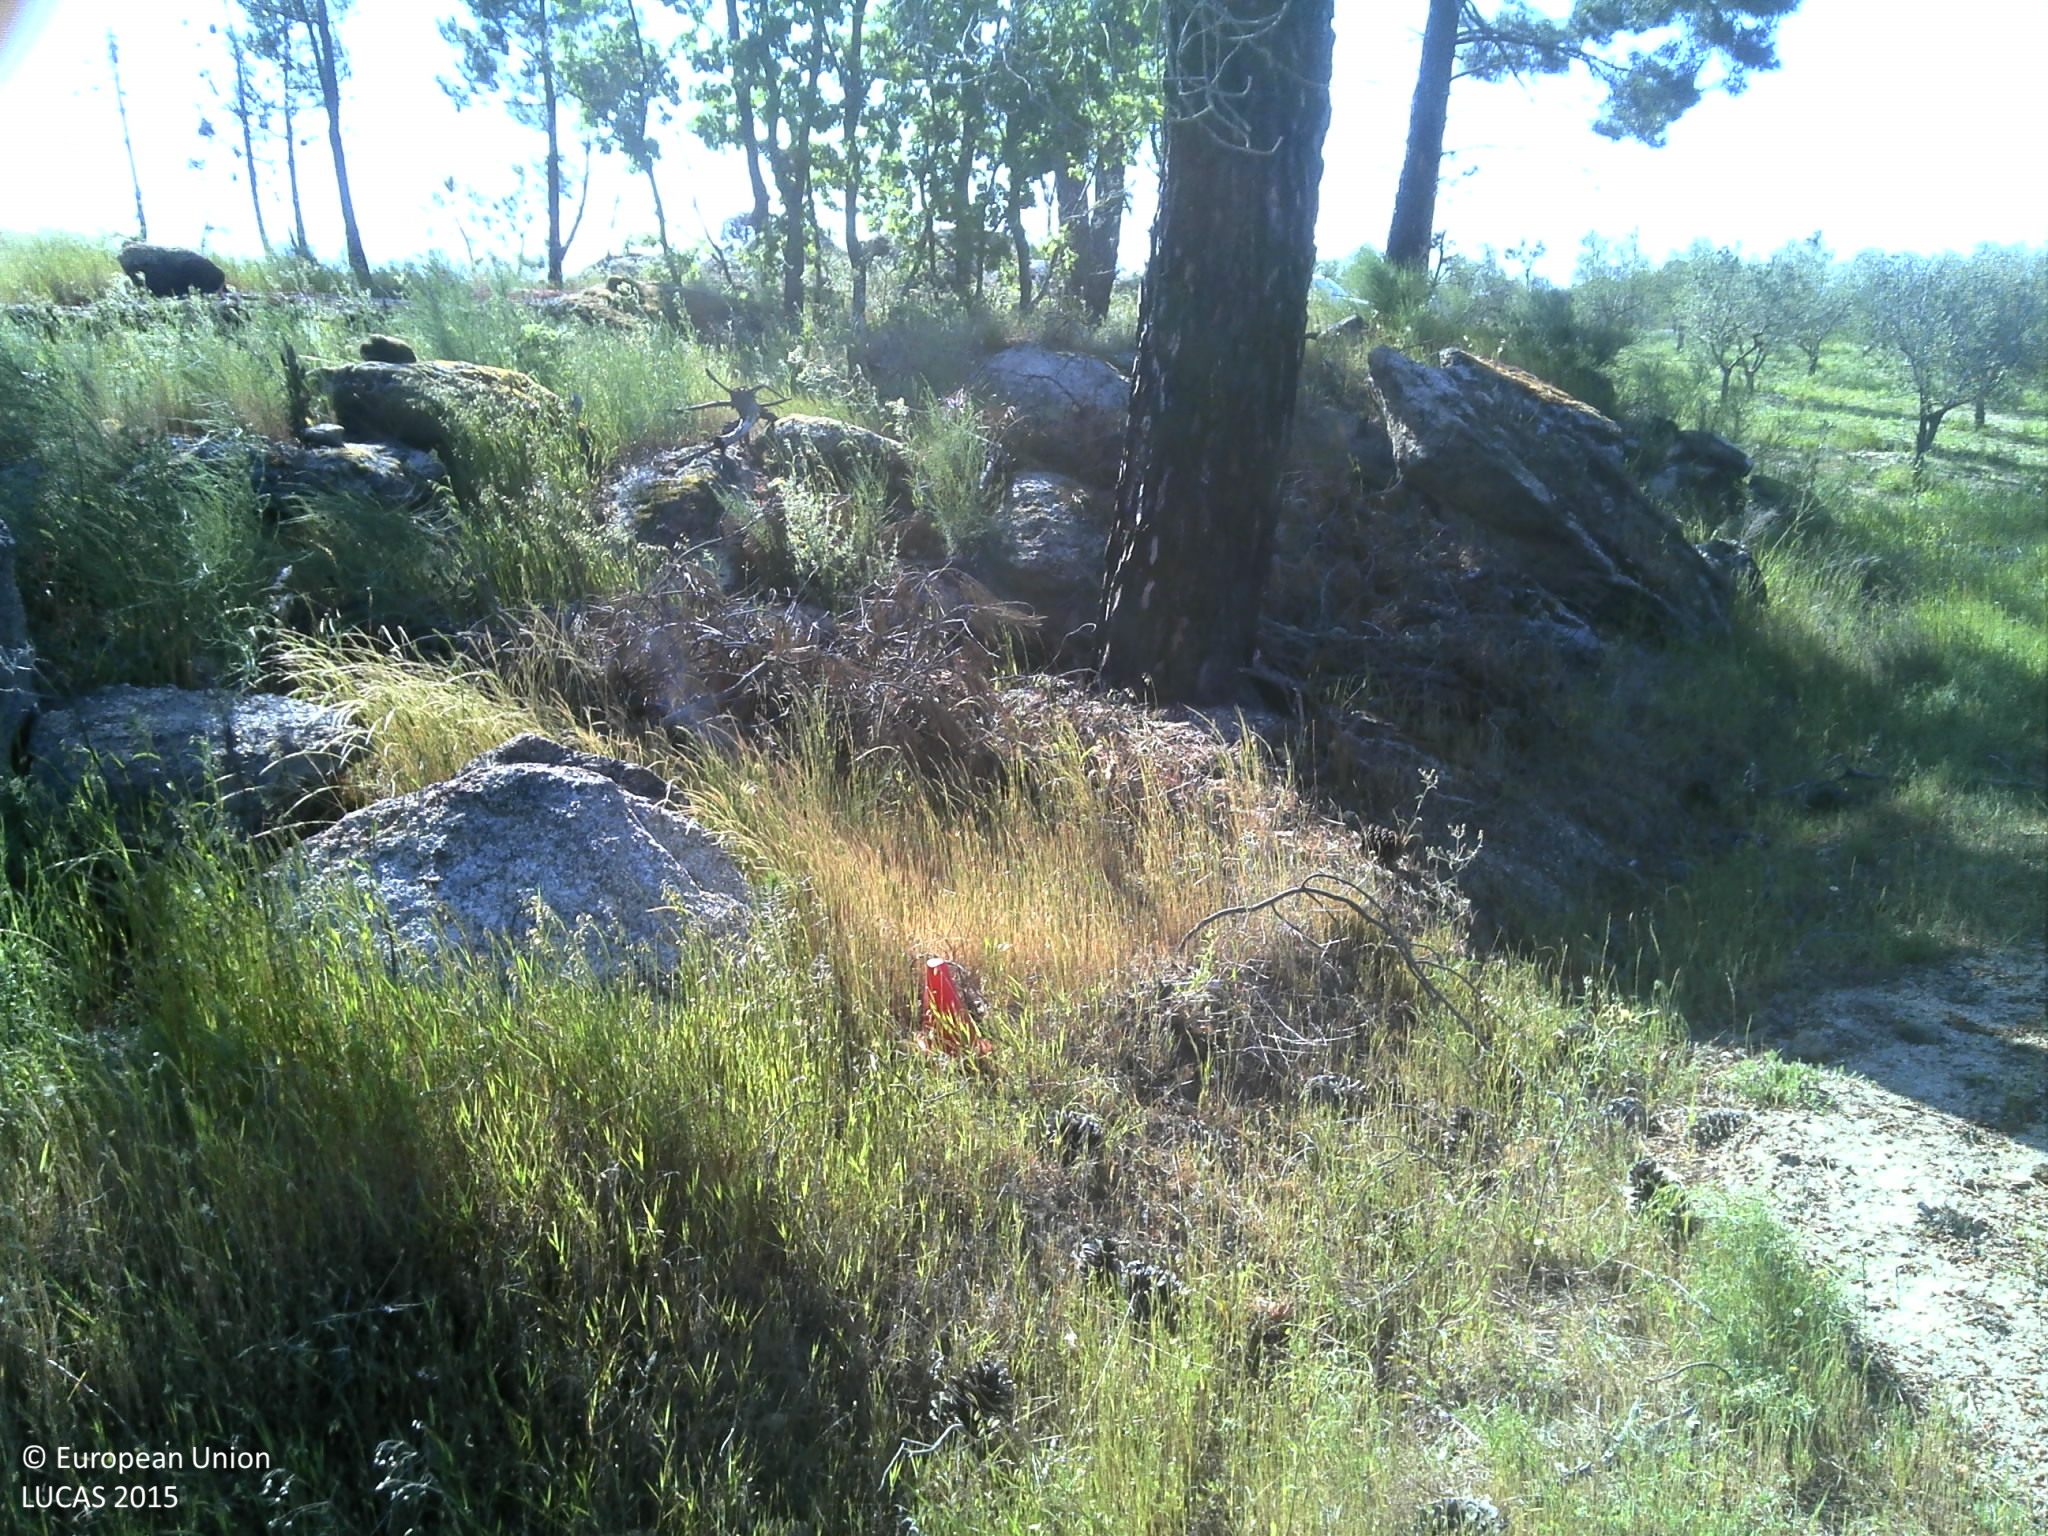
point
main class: Woodland
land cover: Pine dominated mixed woodland
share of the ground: 10 - 25 %
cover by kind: shrubs 50 %, herbaceous plants 15 %, consolidated bare surface 15 %, coniferous forest trees 10 %, broadleaved forest trees 5 %, unconsolidated bare surface 5 %
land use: Forestry
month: May
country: PT
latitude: 41.6443
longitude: -7.3299
